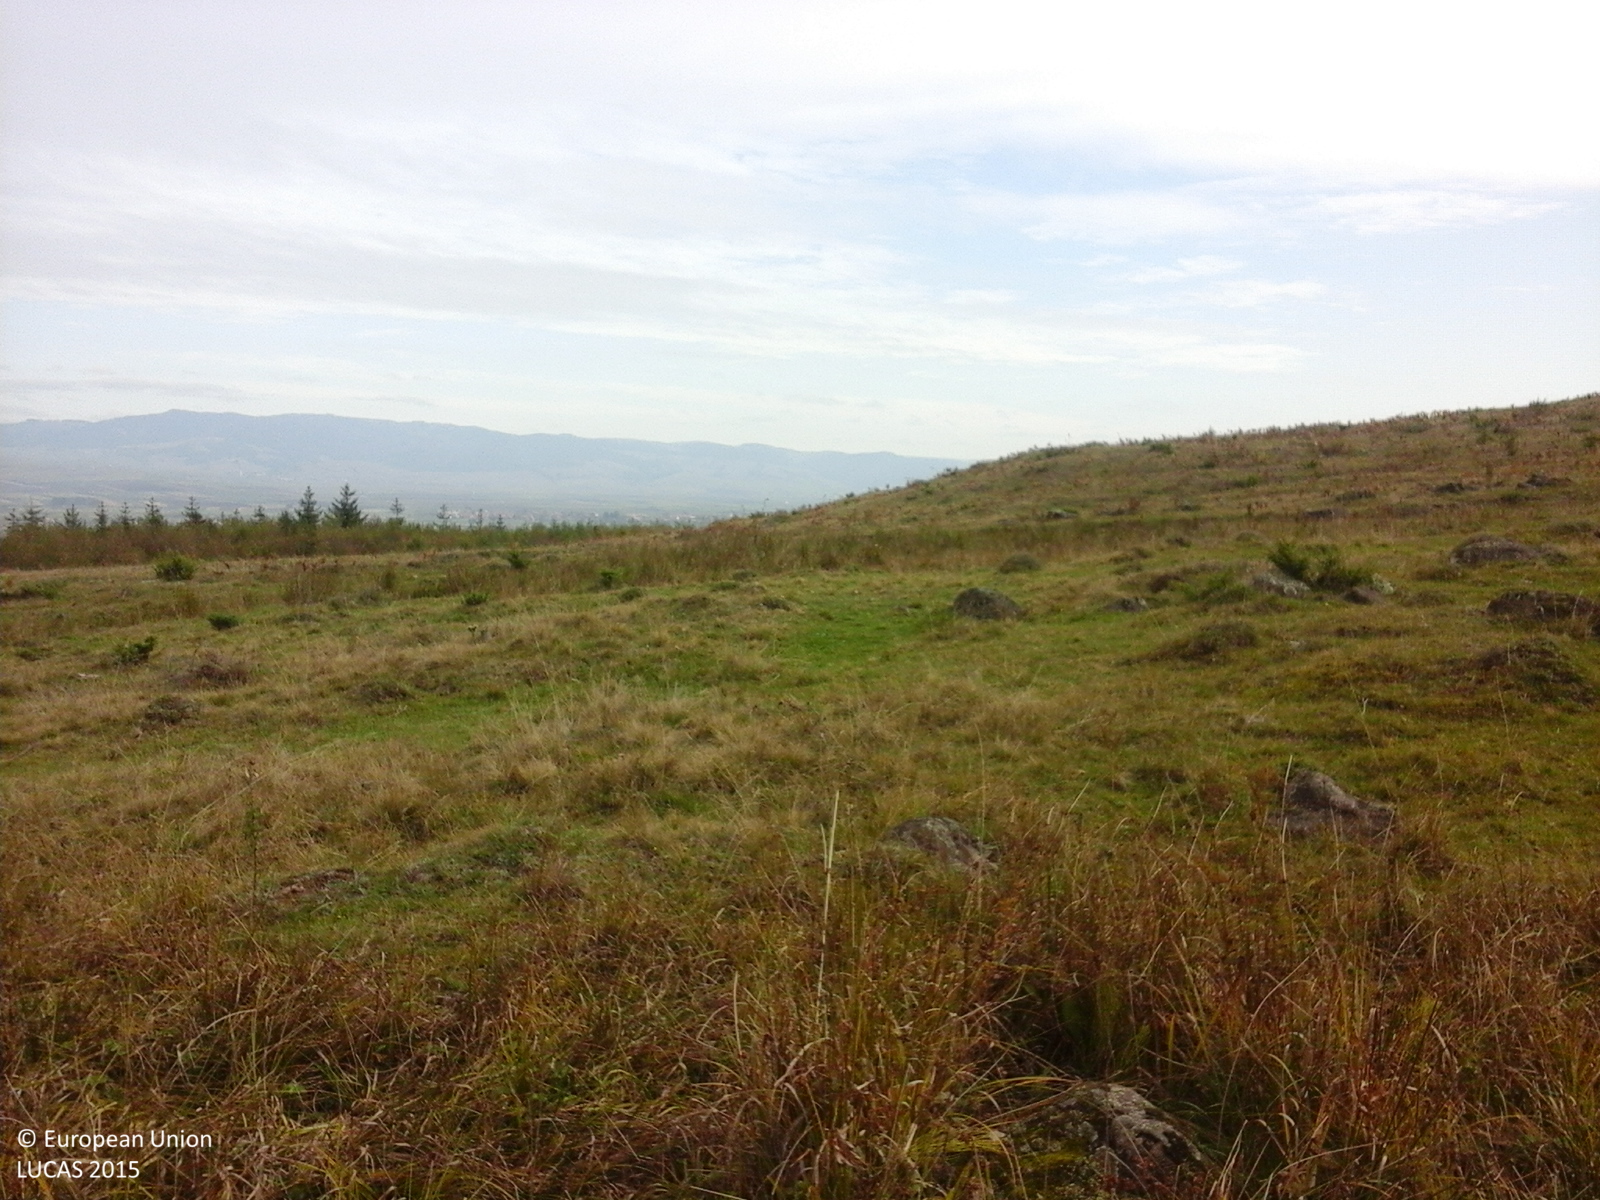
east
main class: Grassland
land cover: Grassland without tree/shrub cover
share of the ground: > 75 %
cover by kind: herbaceous plants 100 %
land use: Agriculture (excluding fallow land and kitchen gardens)
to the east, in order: Grassland without tree/shrub cover; Ditches and canals; Grassland without tree/shrub cover; Shrubland without tree cover; Grassland without tree/shrub cover
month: October
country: RO
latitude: 46.2852
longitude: 25.8065
